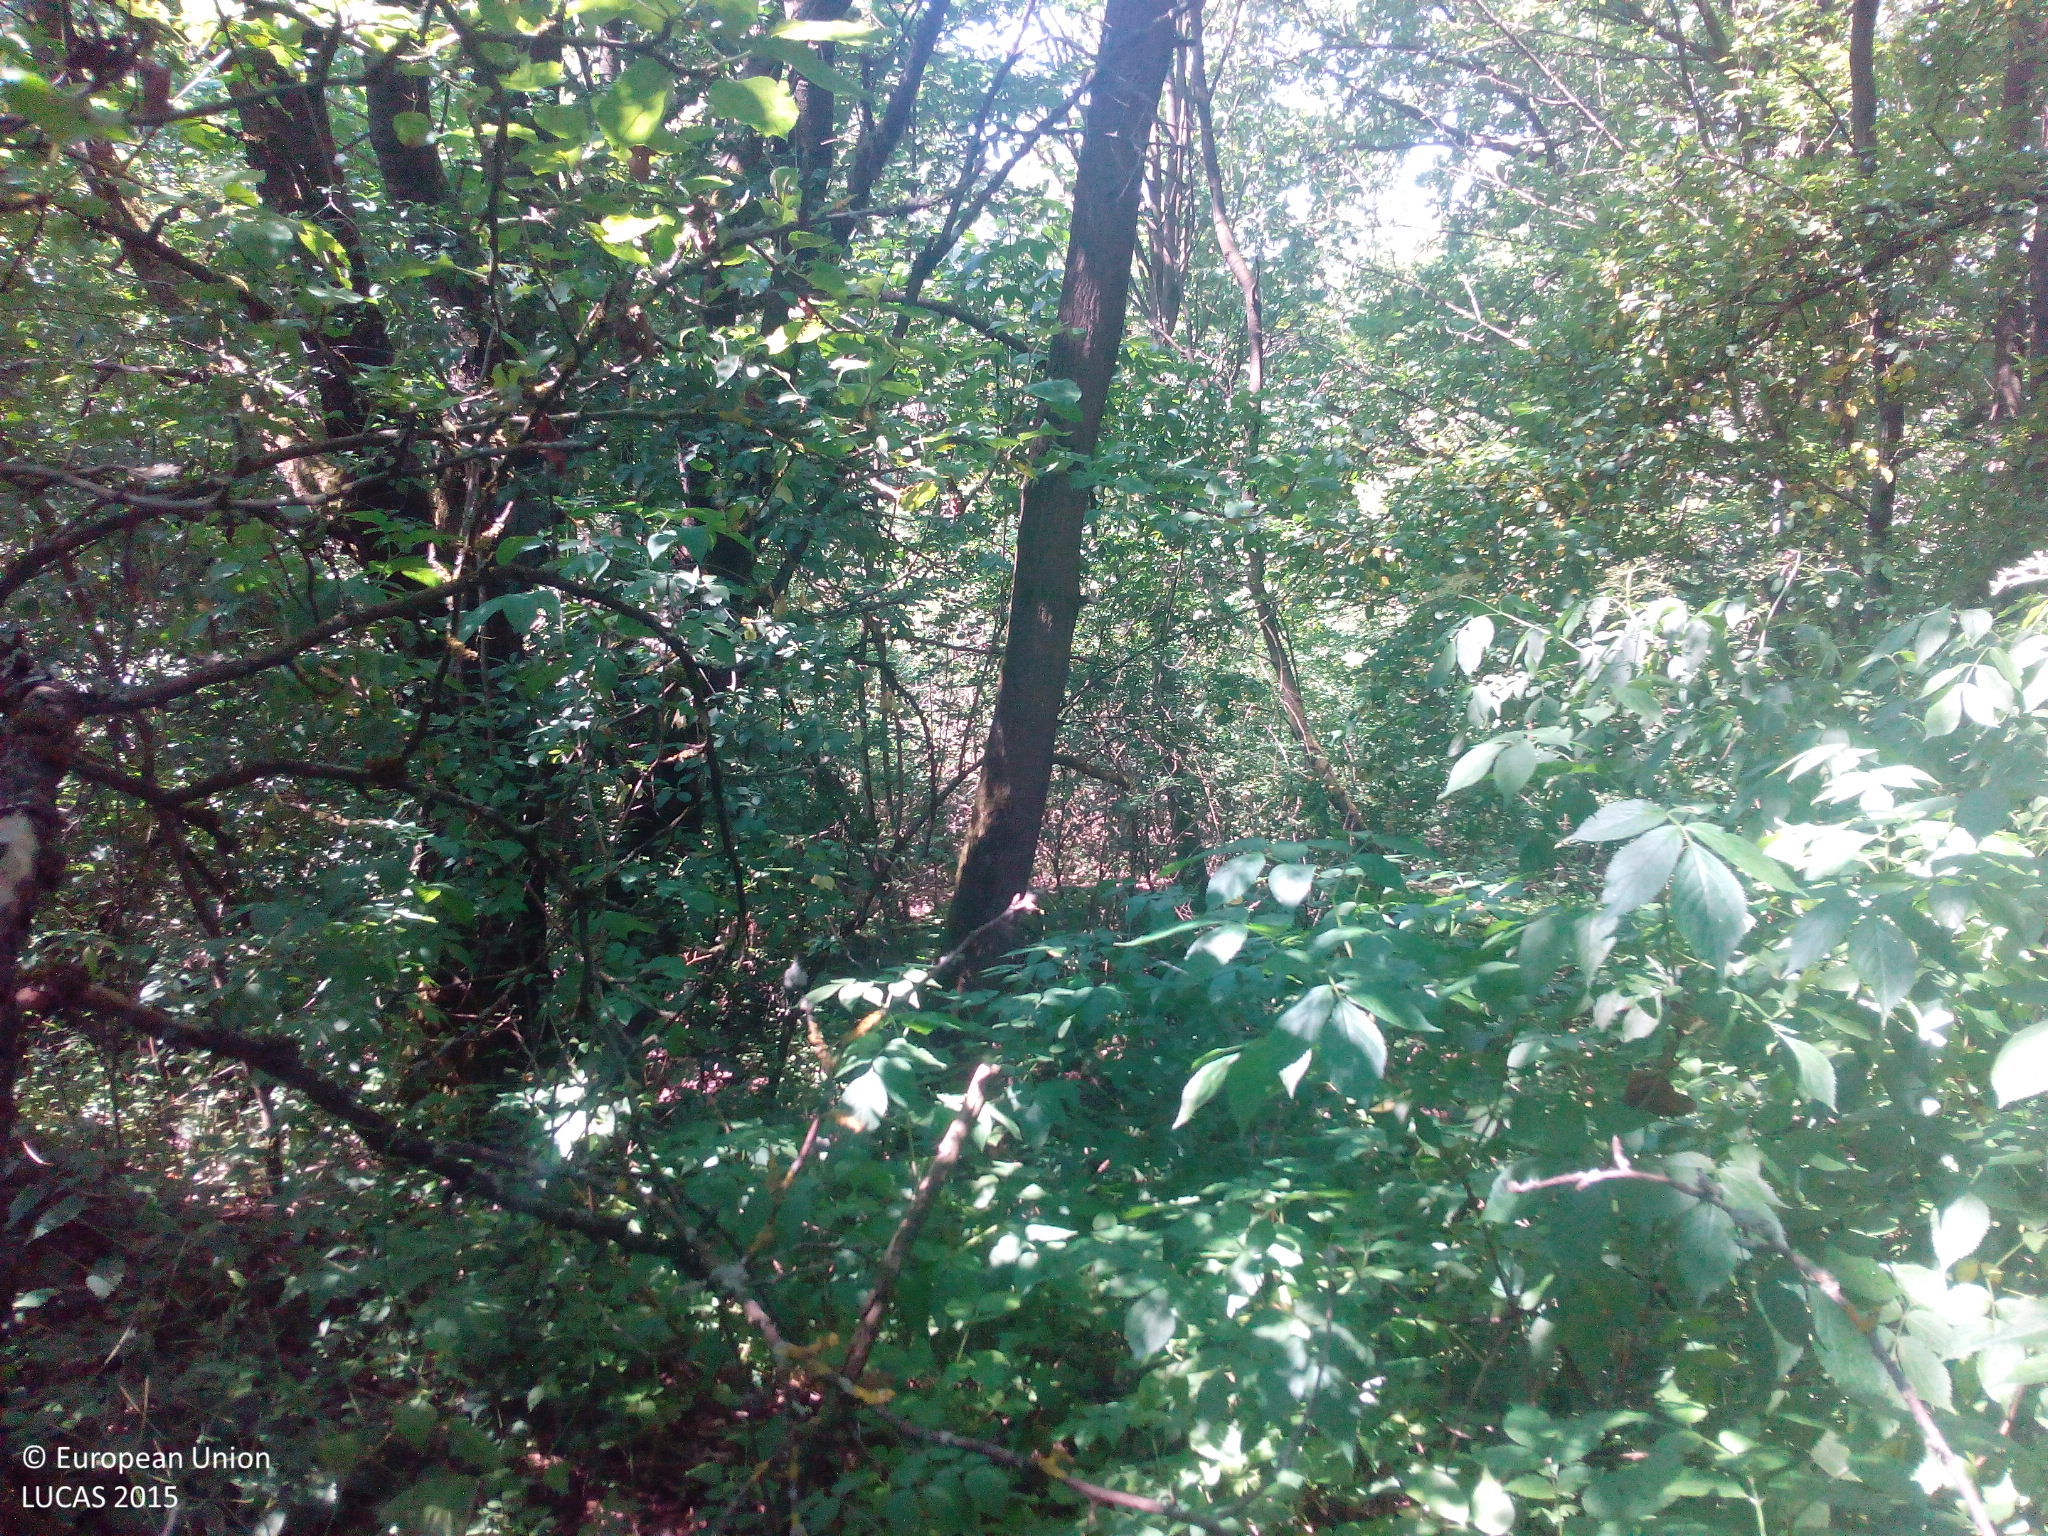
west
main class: Woodland
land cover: Broadleaved woodland
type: mesophytic deciduous forest
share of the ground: > 75 %
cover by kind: broadleaved forest trees 90 %, herbaceous plants 10 %
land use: Semi-natural and natural areas not in use
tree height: > 5 m
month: July
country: DE
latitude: 50.1285
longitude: 10.6293
